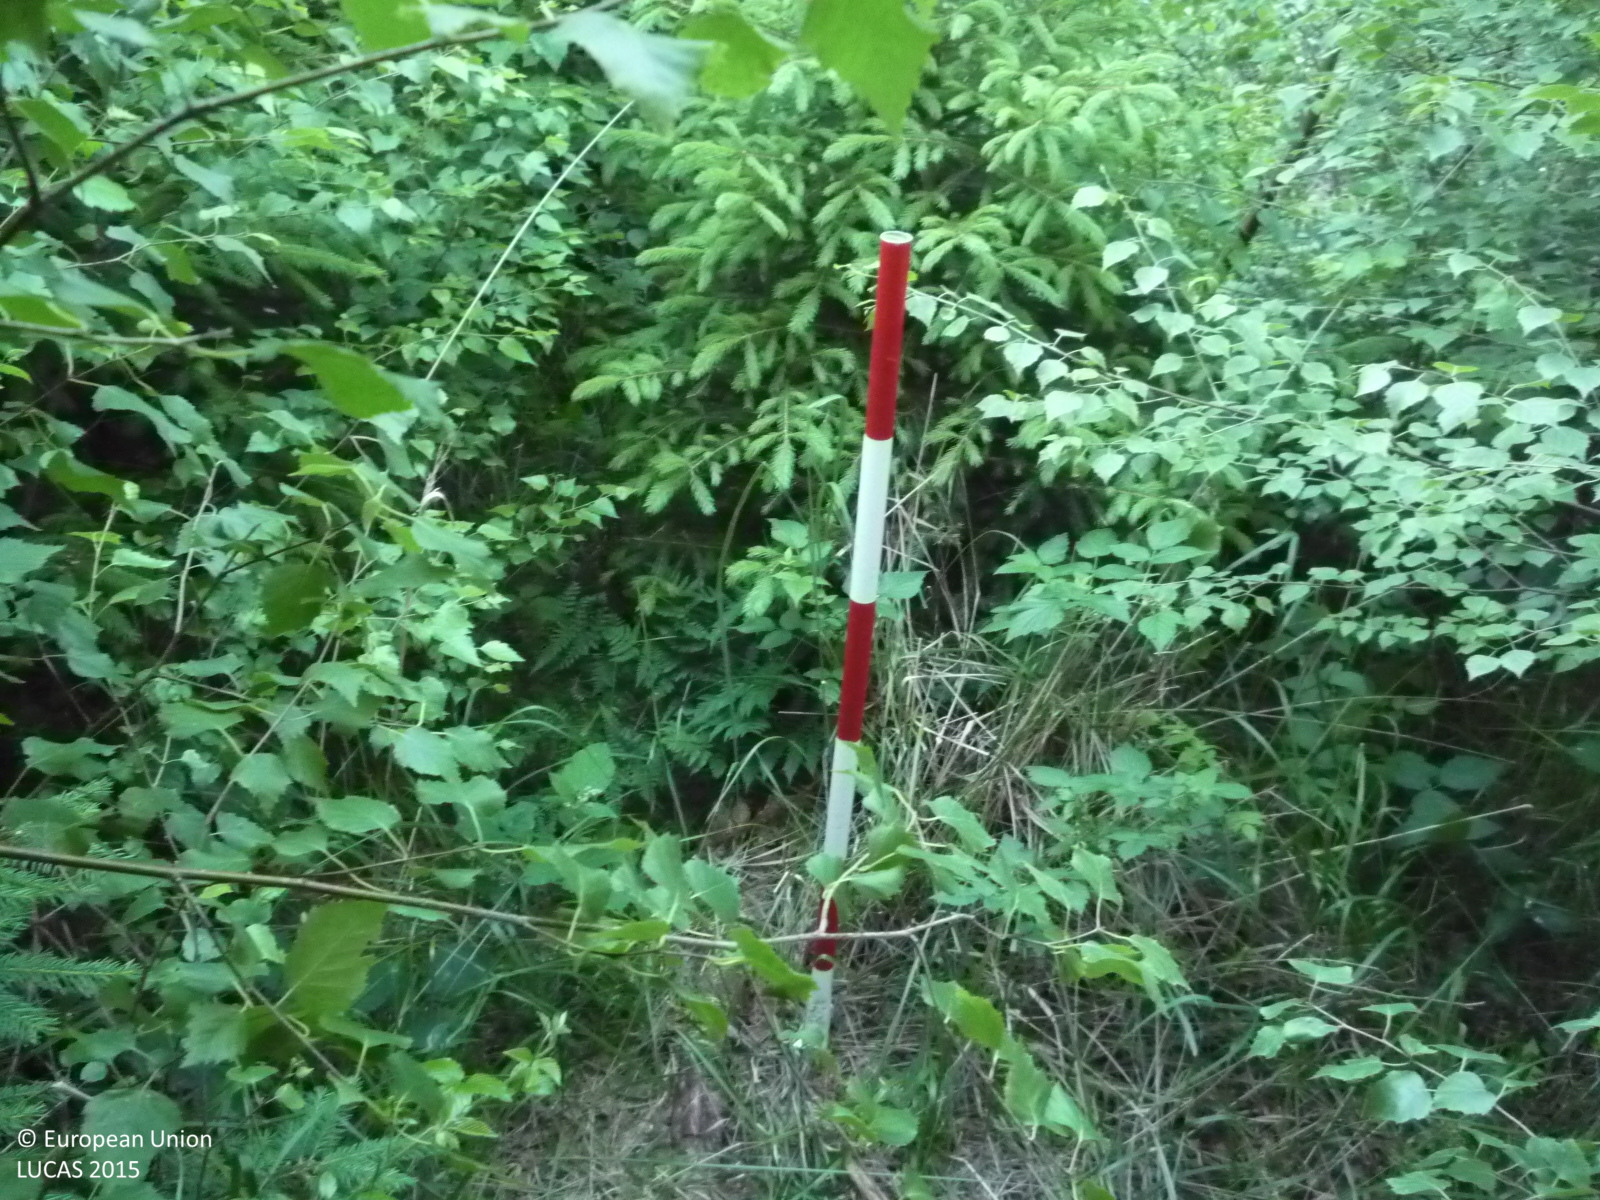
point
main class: Woodland
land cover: Spruce dominated mixed woodland
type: hemiboreal forest and nemoral coniferous forest and mixed broadleaved-coniferous forest
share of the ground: > 75 %
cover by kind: broadleaved forest trees 55 %, coniferous forest trees 30 %, shrubs 15 %
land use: Forestry
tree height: > 5 m
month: June
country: CZ
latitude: 49.7806
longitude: 15.1275
